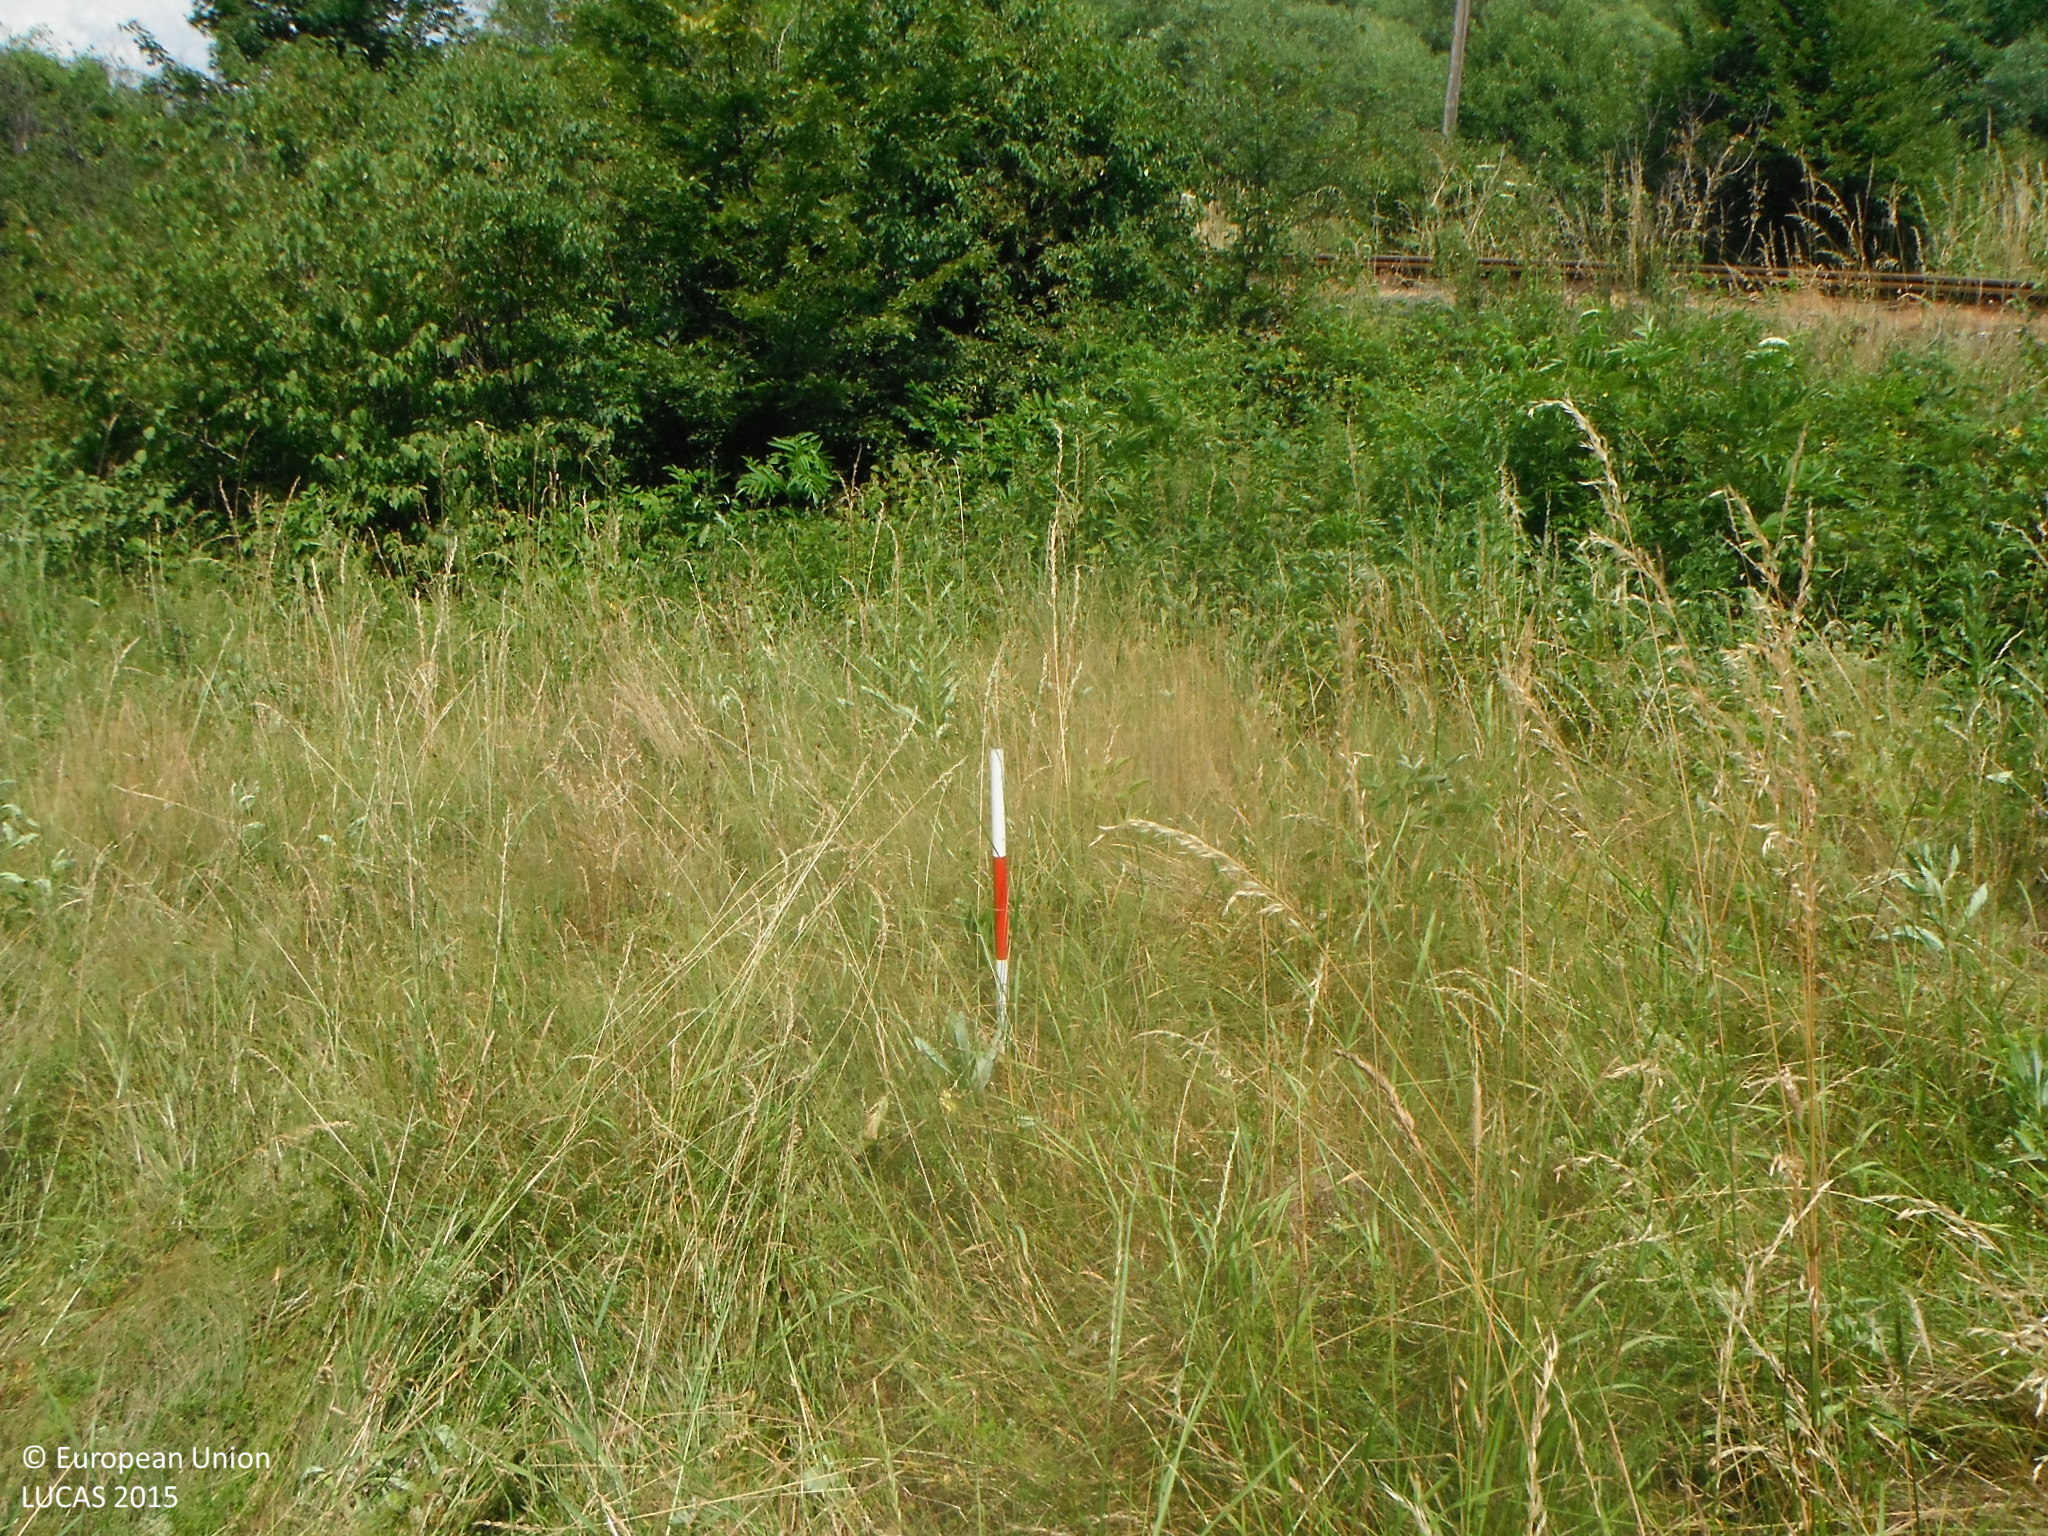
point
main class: Grassland
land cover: Grassland with sparse tree/shrub cover
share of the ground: > 75 %
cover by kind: herbaceous plants 90 %, broadleaved forest trees 5 %, shrubs 5 %
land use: Semi-natural and natural areas not in use
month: July
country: SK
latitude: 48.4090
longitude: 19.0860
